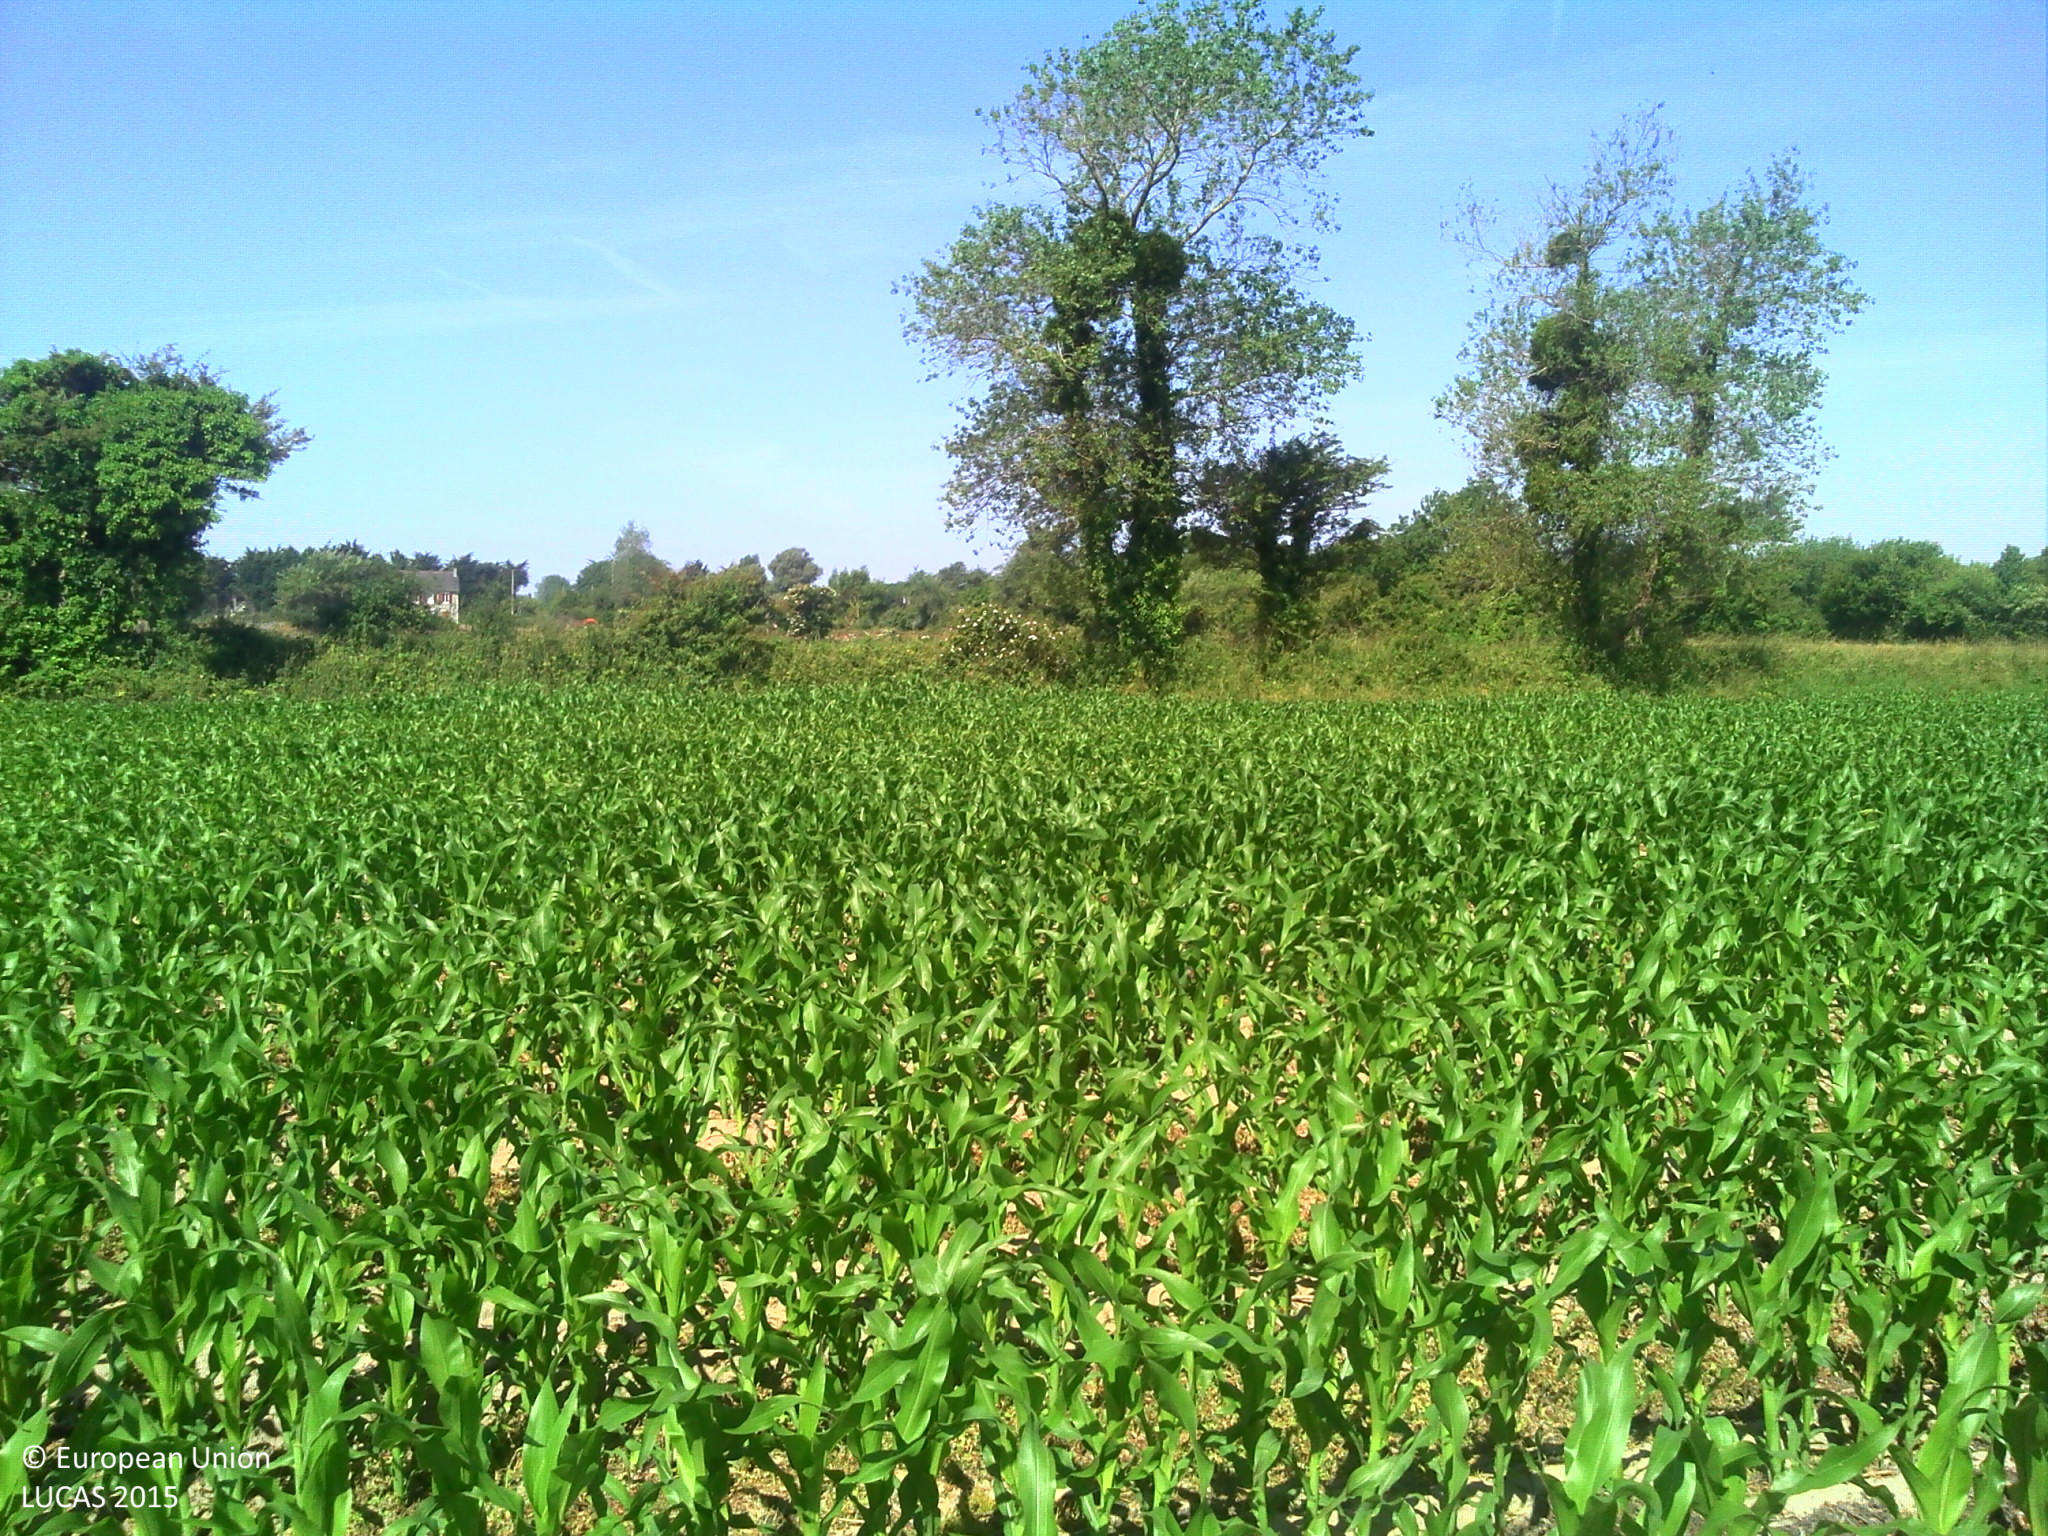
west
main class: Cropland
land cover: Maize
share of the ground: 50 - 75 %
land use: Agriculture (excluding fallow land and kitchen gardens)
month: June
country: FR
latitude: 49.3095
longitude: -1.6741
